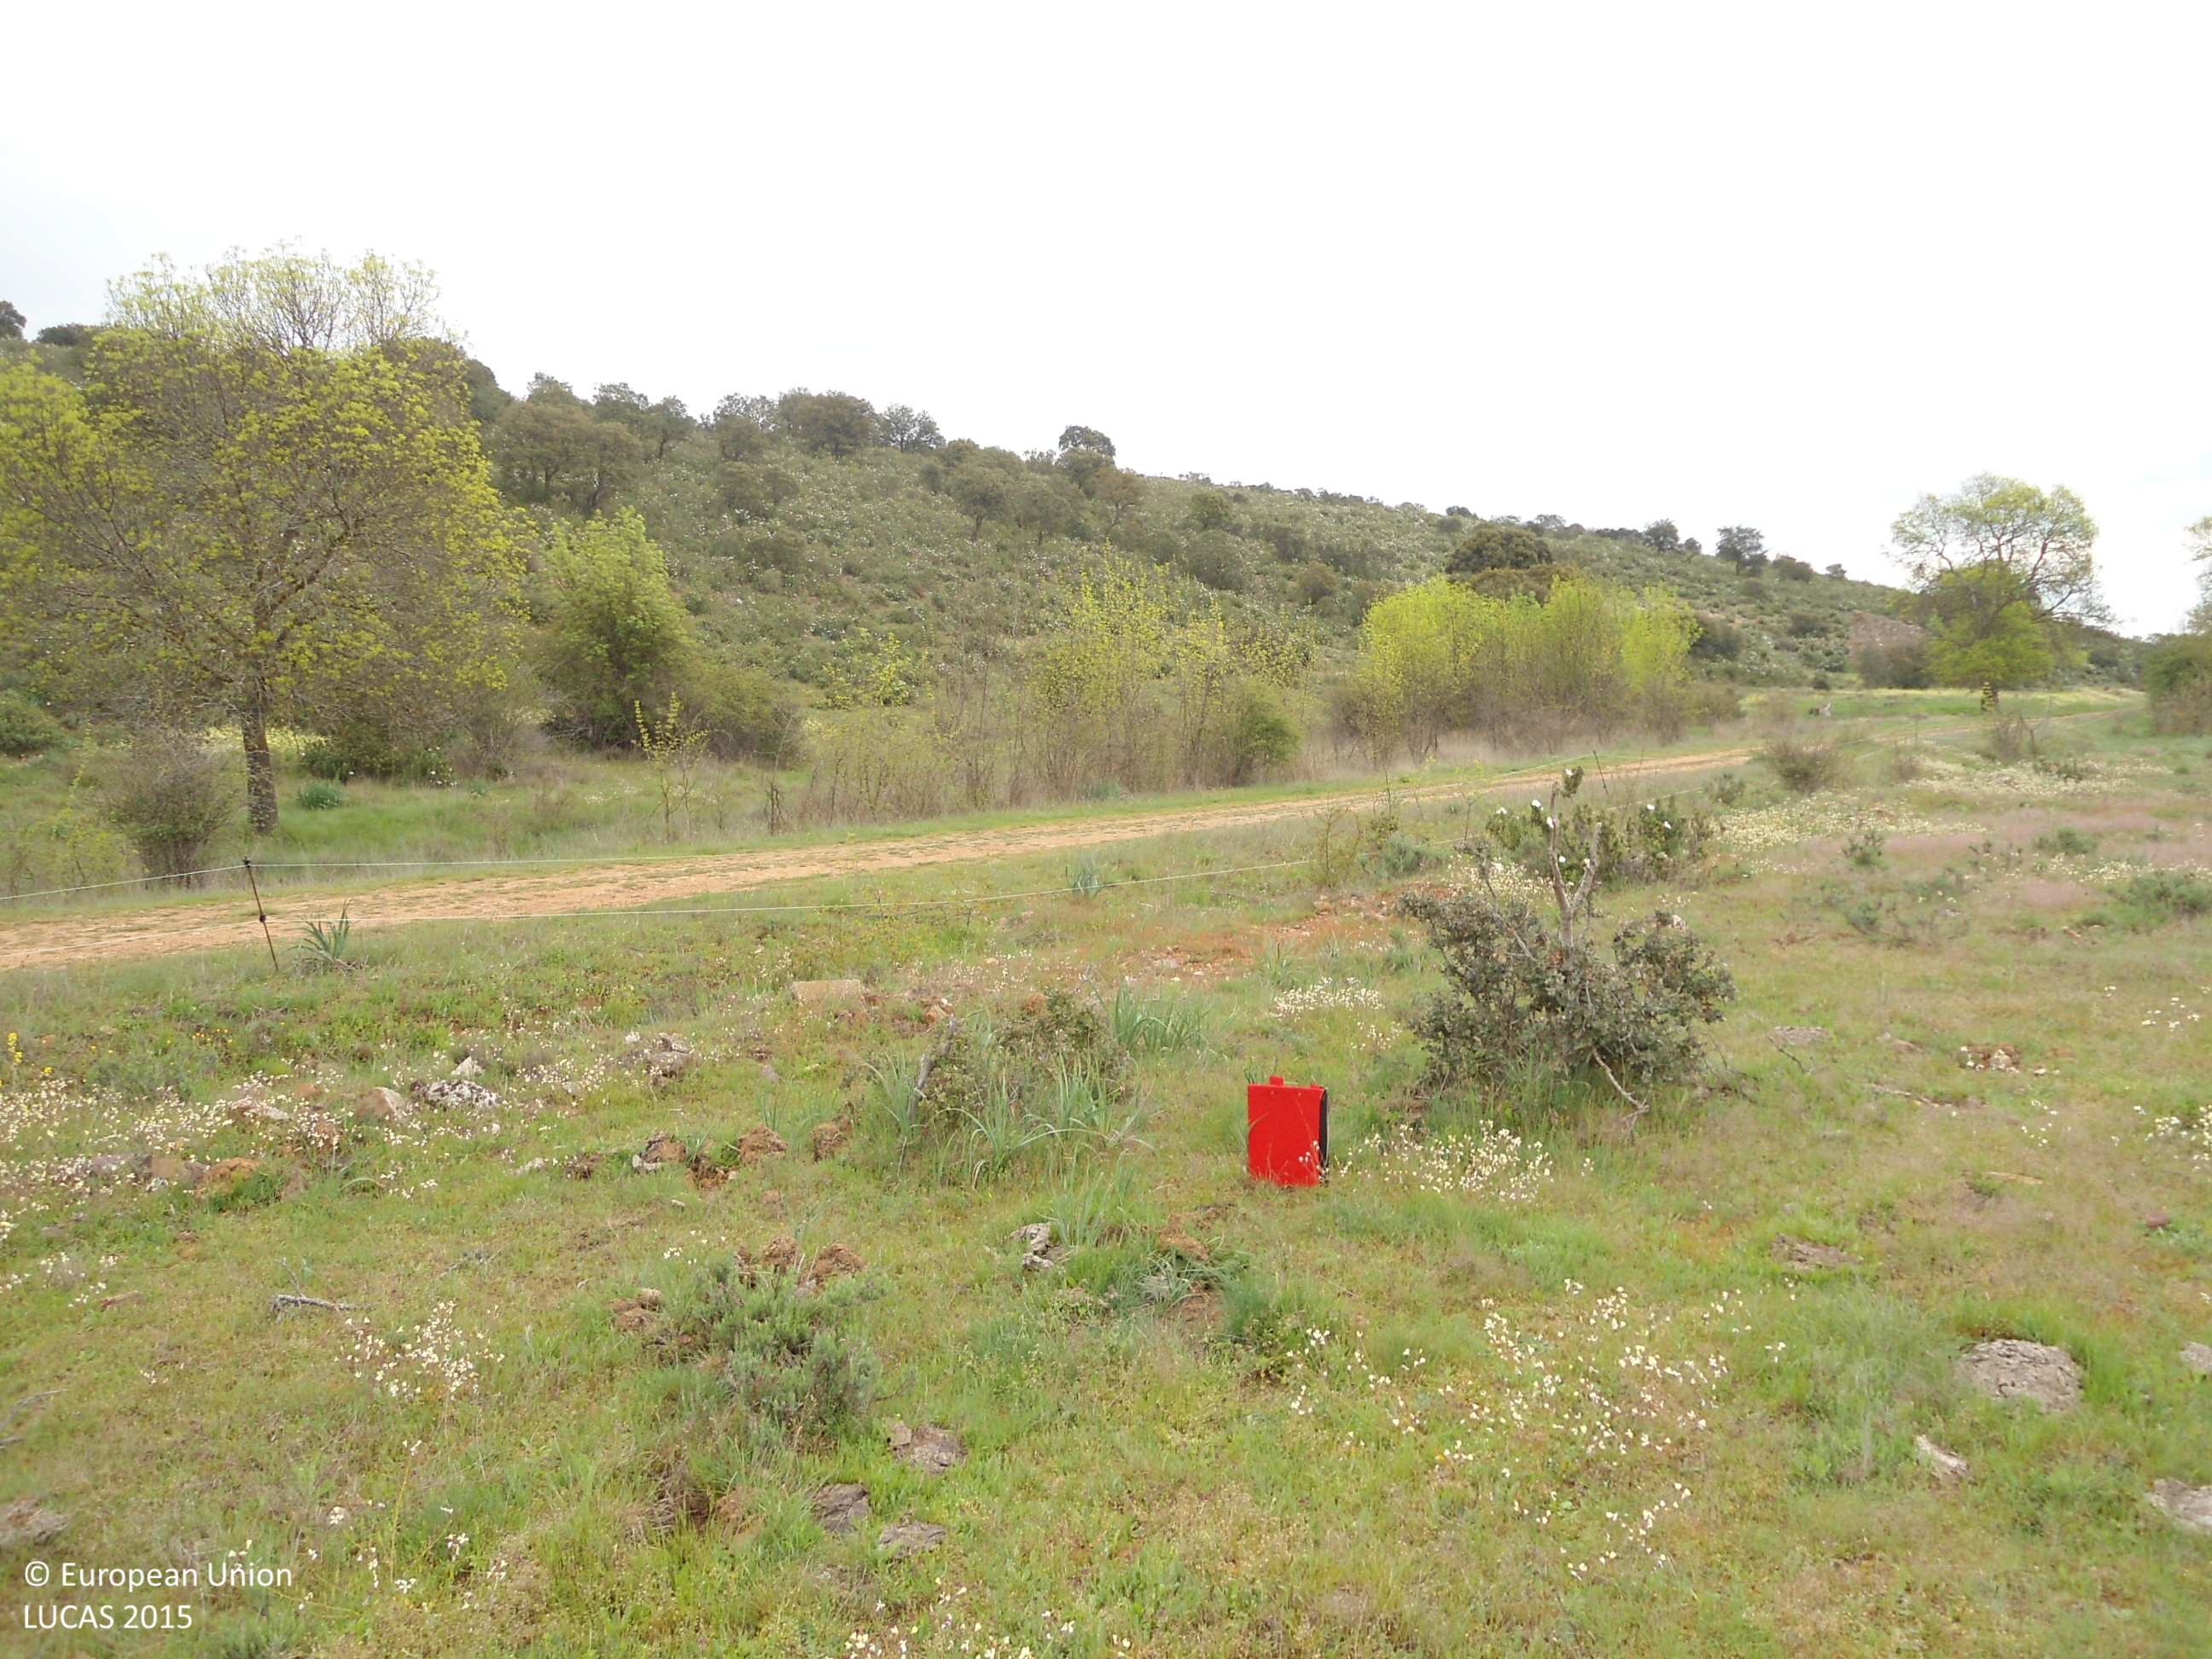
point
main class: Grassland
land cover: Grassland with sparse tree/shrub cover
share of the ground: > 75 %
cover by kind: herbaceous plants 90 %, broadleaved forest trees 5 %, shrubs 5 %
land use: Agriculture (excluding fallow land and kitchen gardens)
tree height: < 5 m
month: April
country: ES
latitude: 41.7409
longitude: -5.8802
